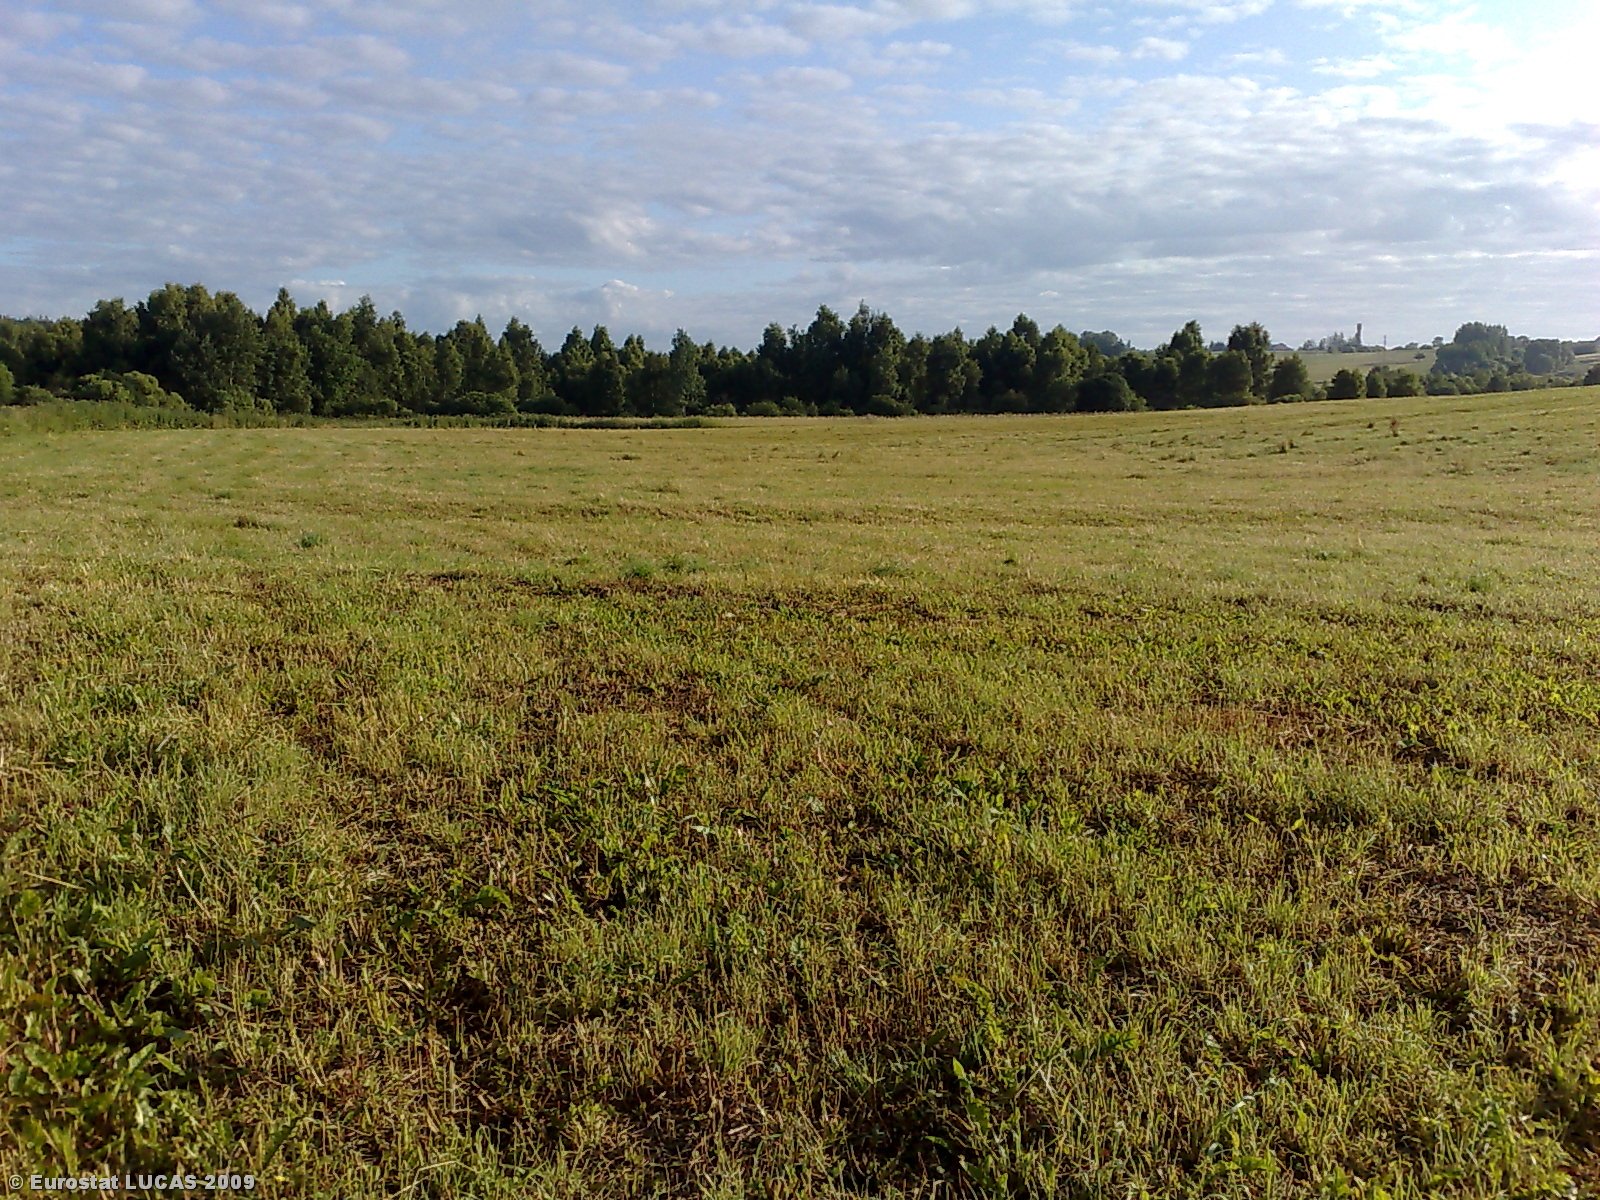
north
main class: Grassland
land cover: Grassland without tree/shrub cover
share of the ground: > 75 %
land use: Agriculture (excluding fallow land and kitchen gardens)
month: July
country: LT
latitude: 55.6708
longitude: 22.8012
